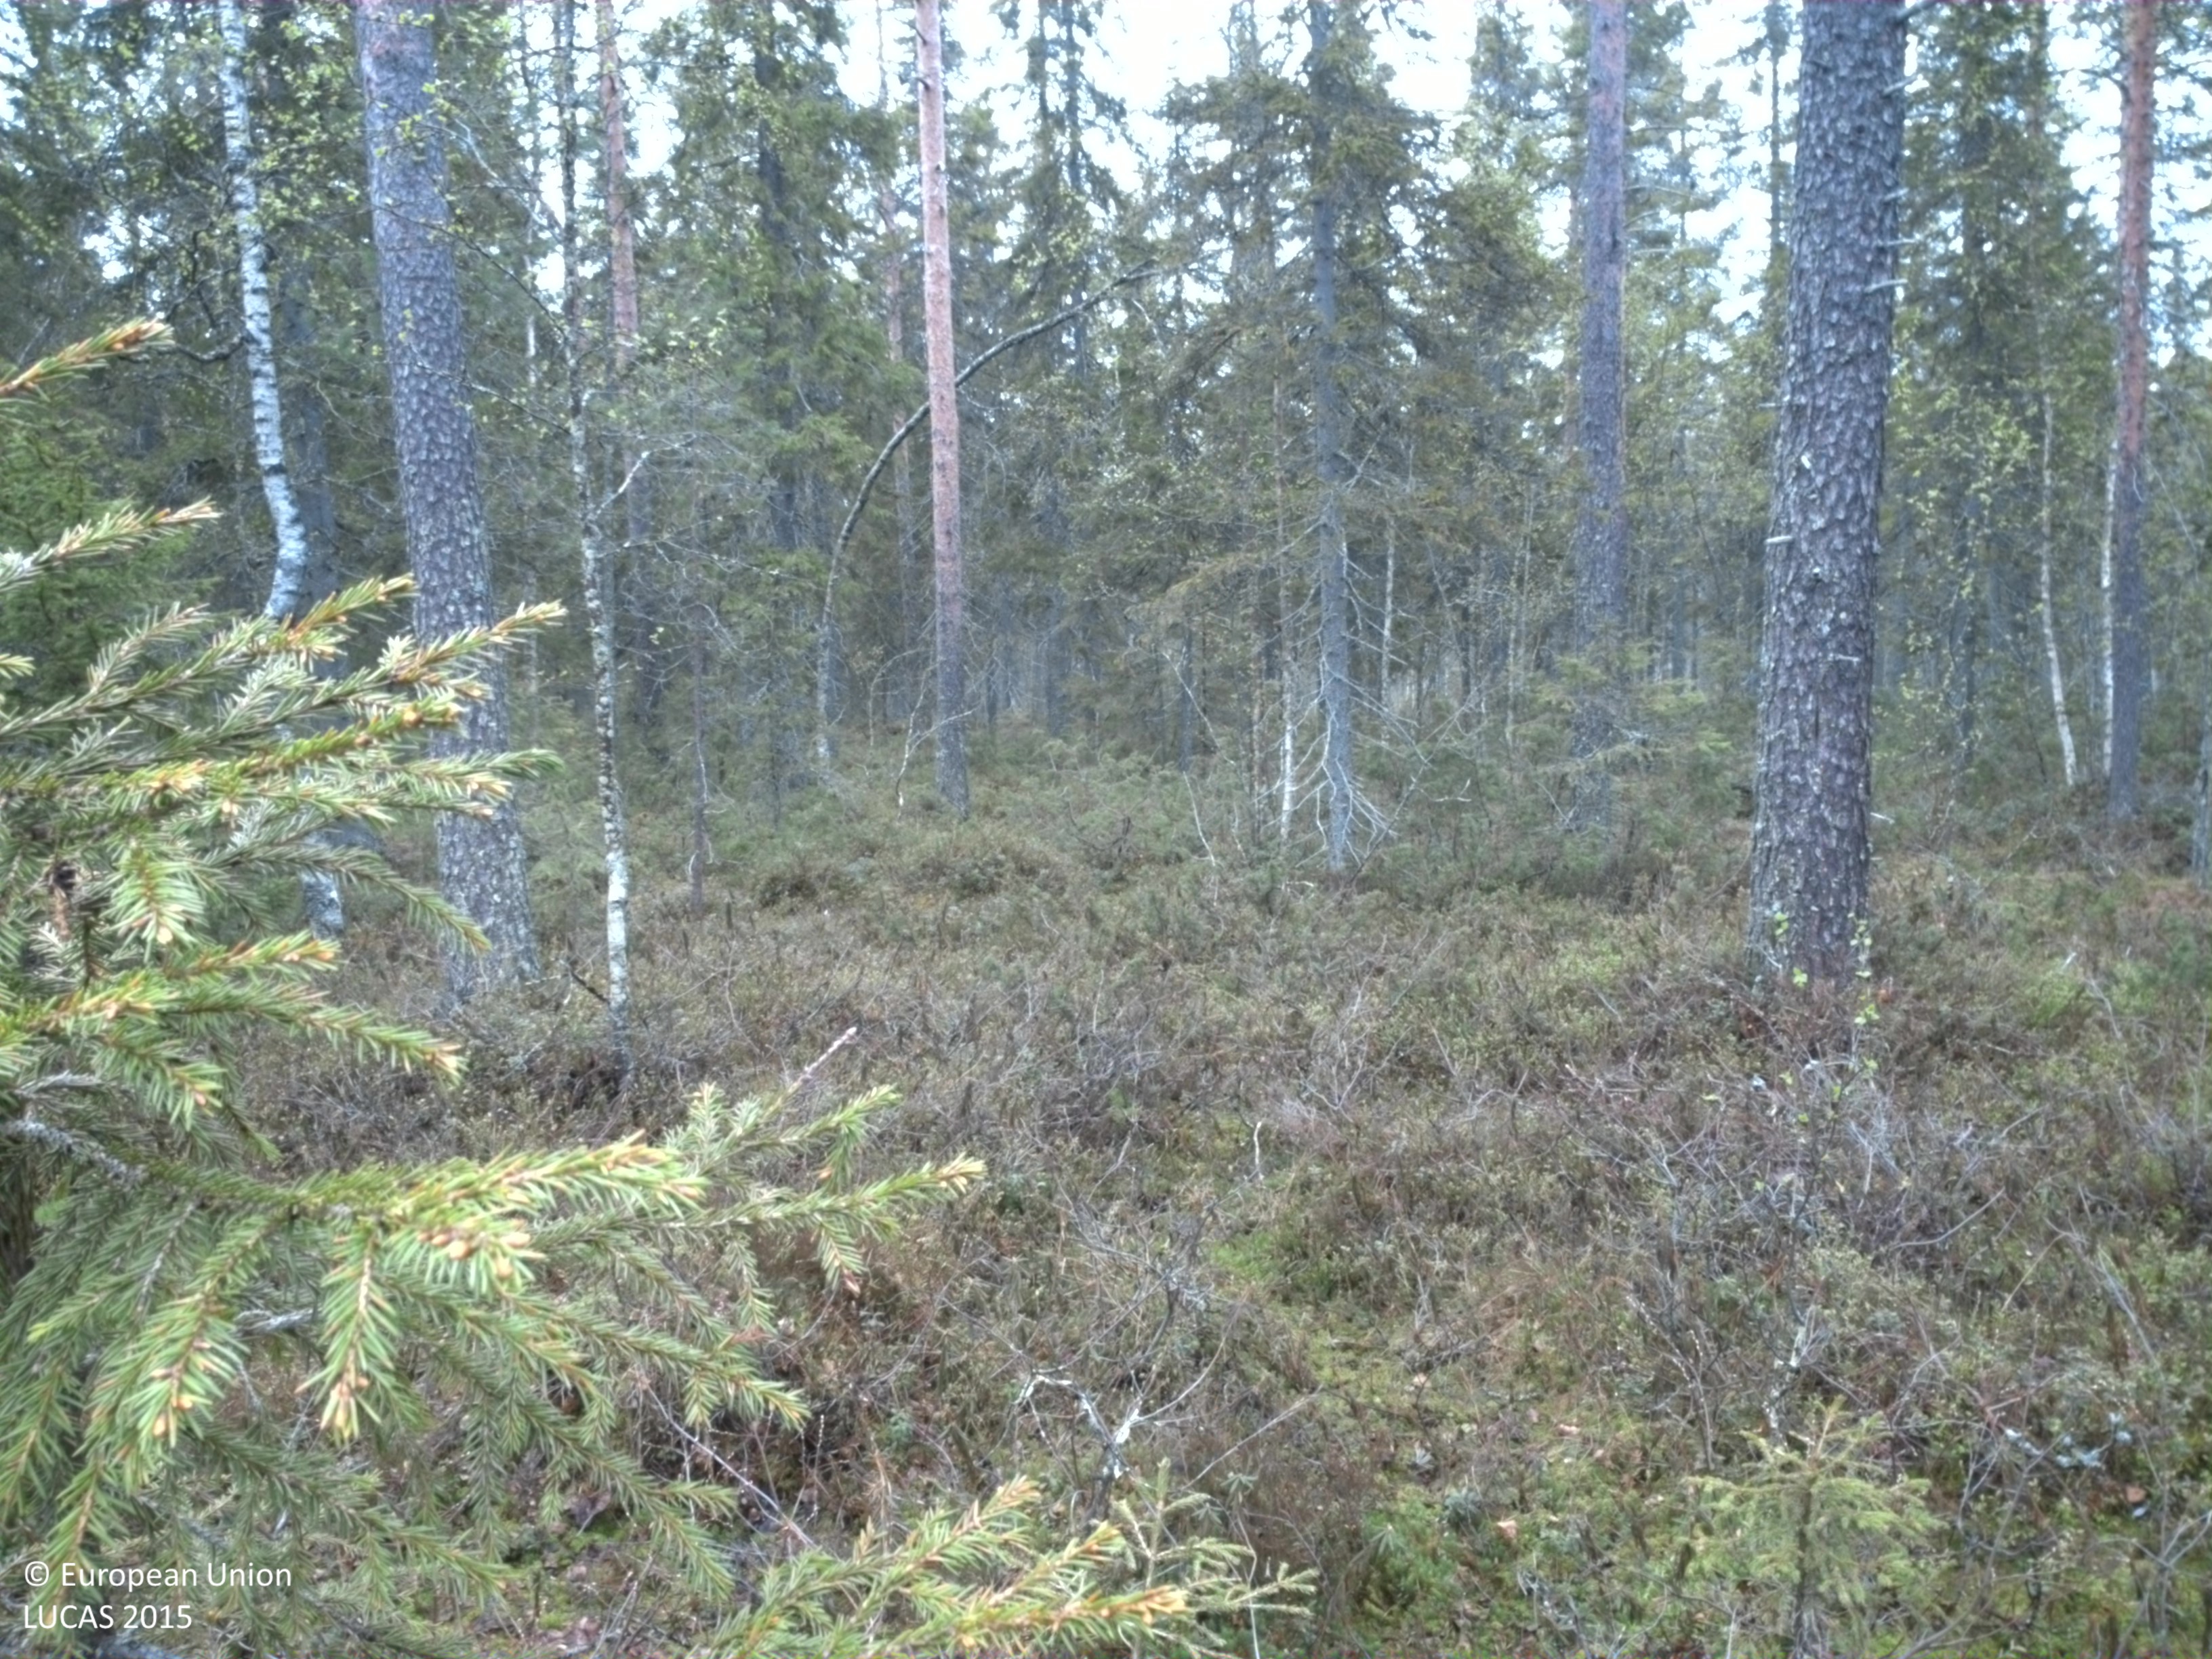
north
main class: Woodland
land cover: Pine dominated mixed woodland
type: mire and swamp forests
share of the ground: 25 - 50 %
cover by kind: shrubs 40 %, coniferous forest trees 25 %, broadleaved forest trees 25 %, herbaceous plants 5 %, lichens and mosses 5 %
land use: Forestry
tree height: > 5 m
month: May
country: SE
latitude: 66.0525
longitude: 23.1666
